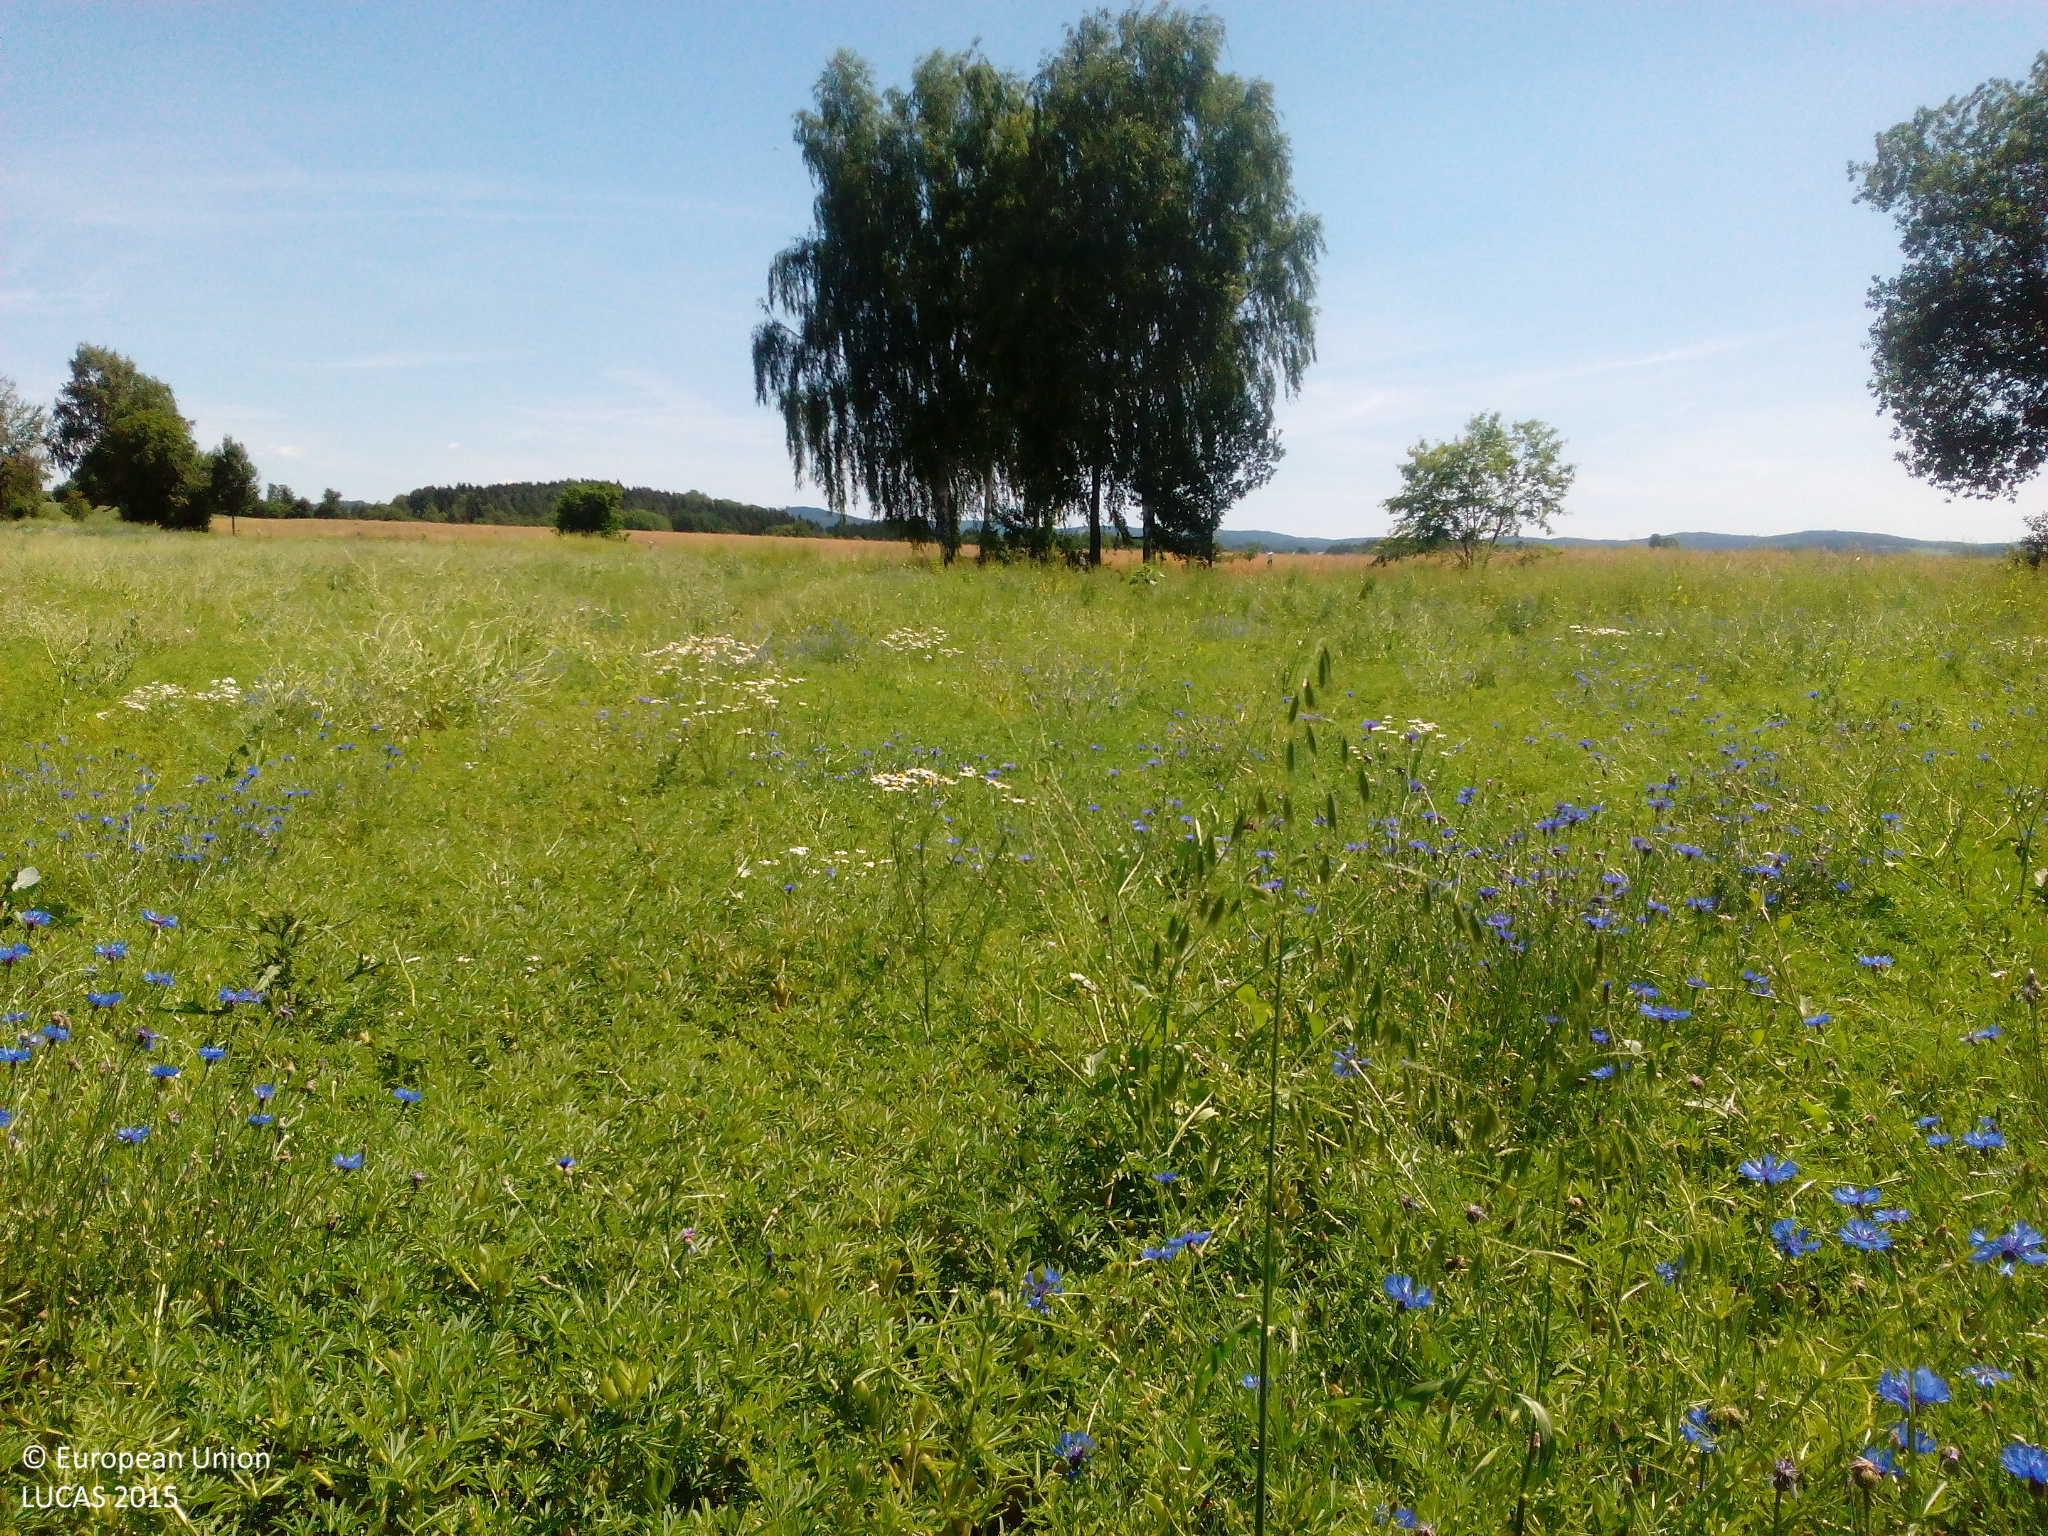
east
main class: Cropland
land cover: Dry pulses
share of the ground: > 75 %
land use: Agriculture (excluding fallow land and kitchen gardens)
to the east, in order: Dry pulses; Grass margins; Ditches and canals; Grass margins; Paved roads, cycling and walking lanes; Grass margins; Abandoned hedges; Rape and turnip rape
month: July
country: DE
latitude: 49.7486
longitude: 12.2340
